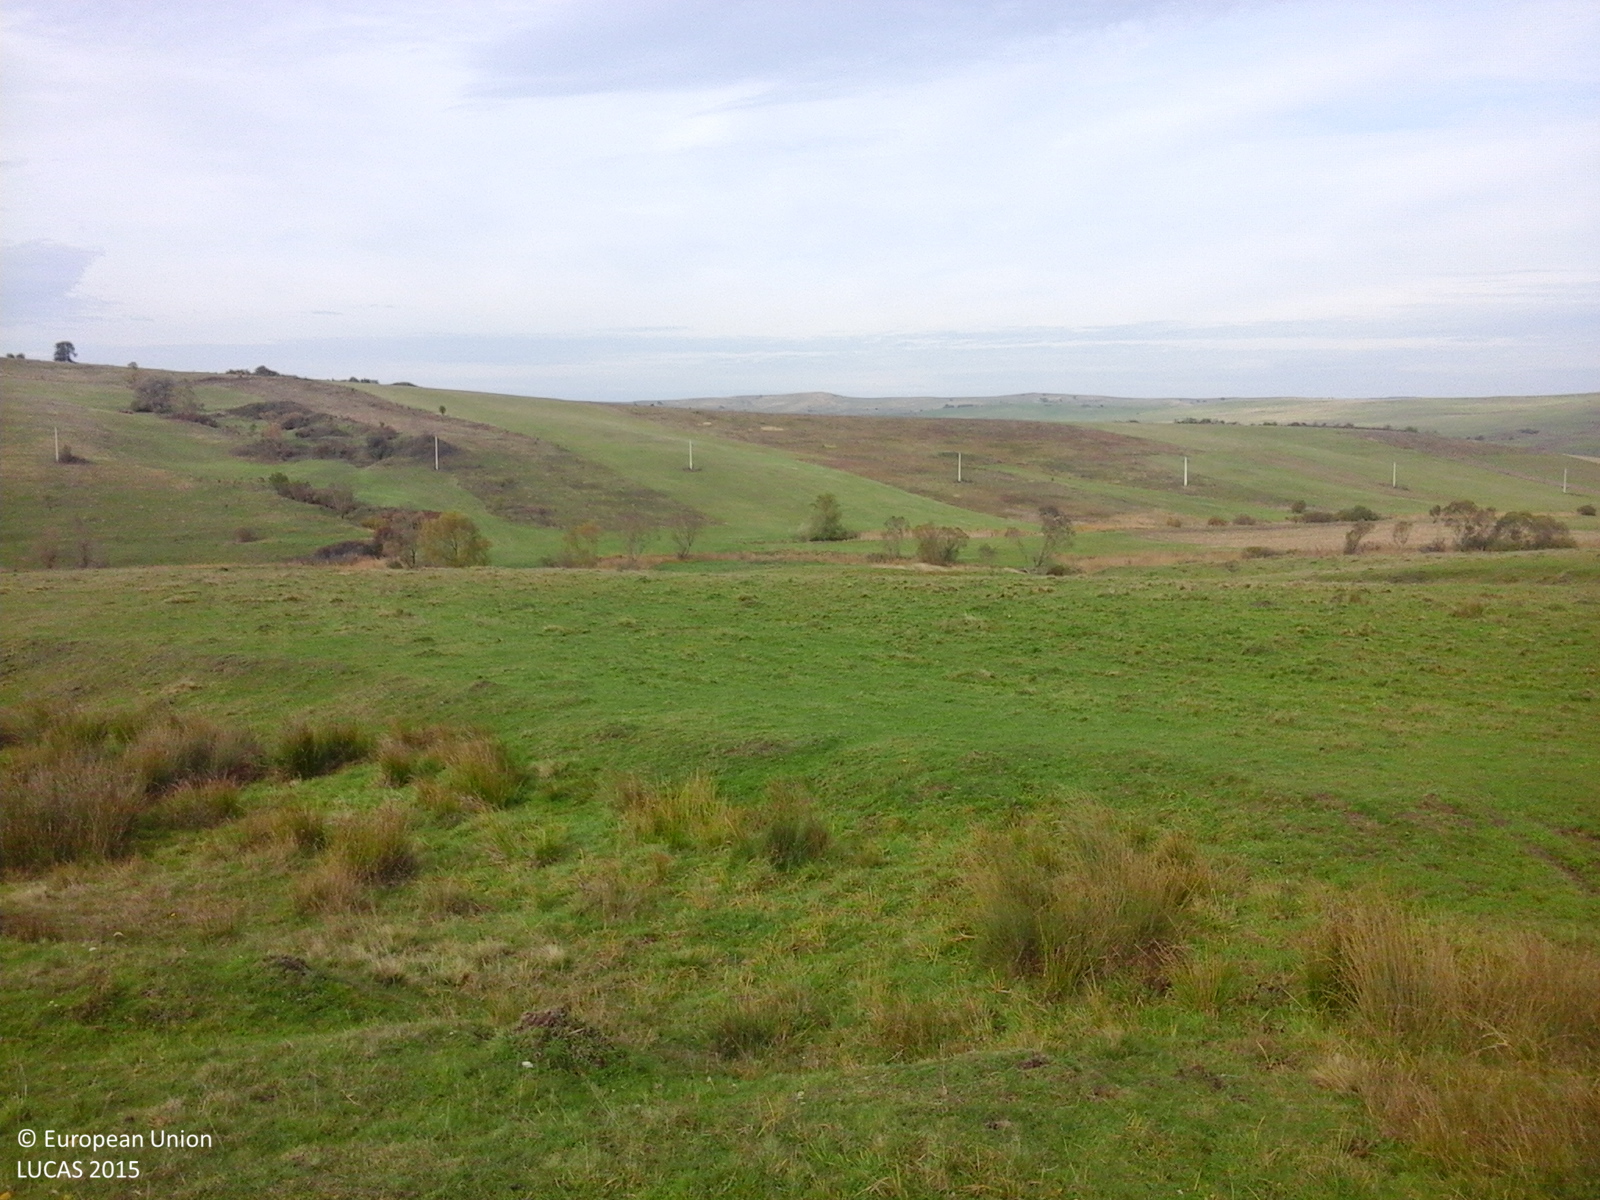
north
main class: Grassland
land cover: Grassland without tree/shrub cover
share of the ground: > 75 %
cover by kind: herbaceous plants 100 %
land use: Agriculture (excluding fallow land and kitchen gardens)
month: October
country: RO
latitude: 45.9849
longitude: 24.9771
